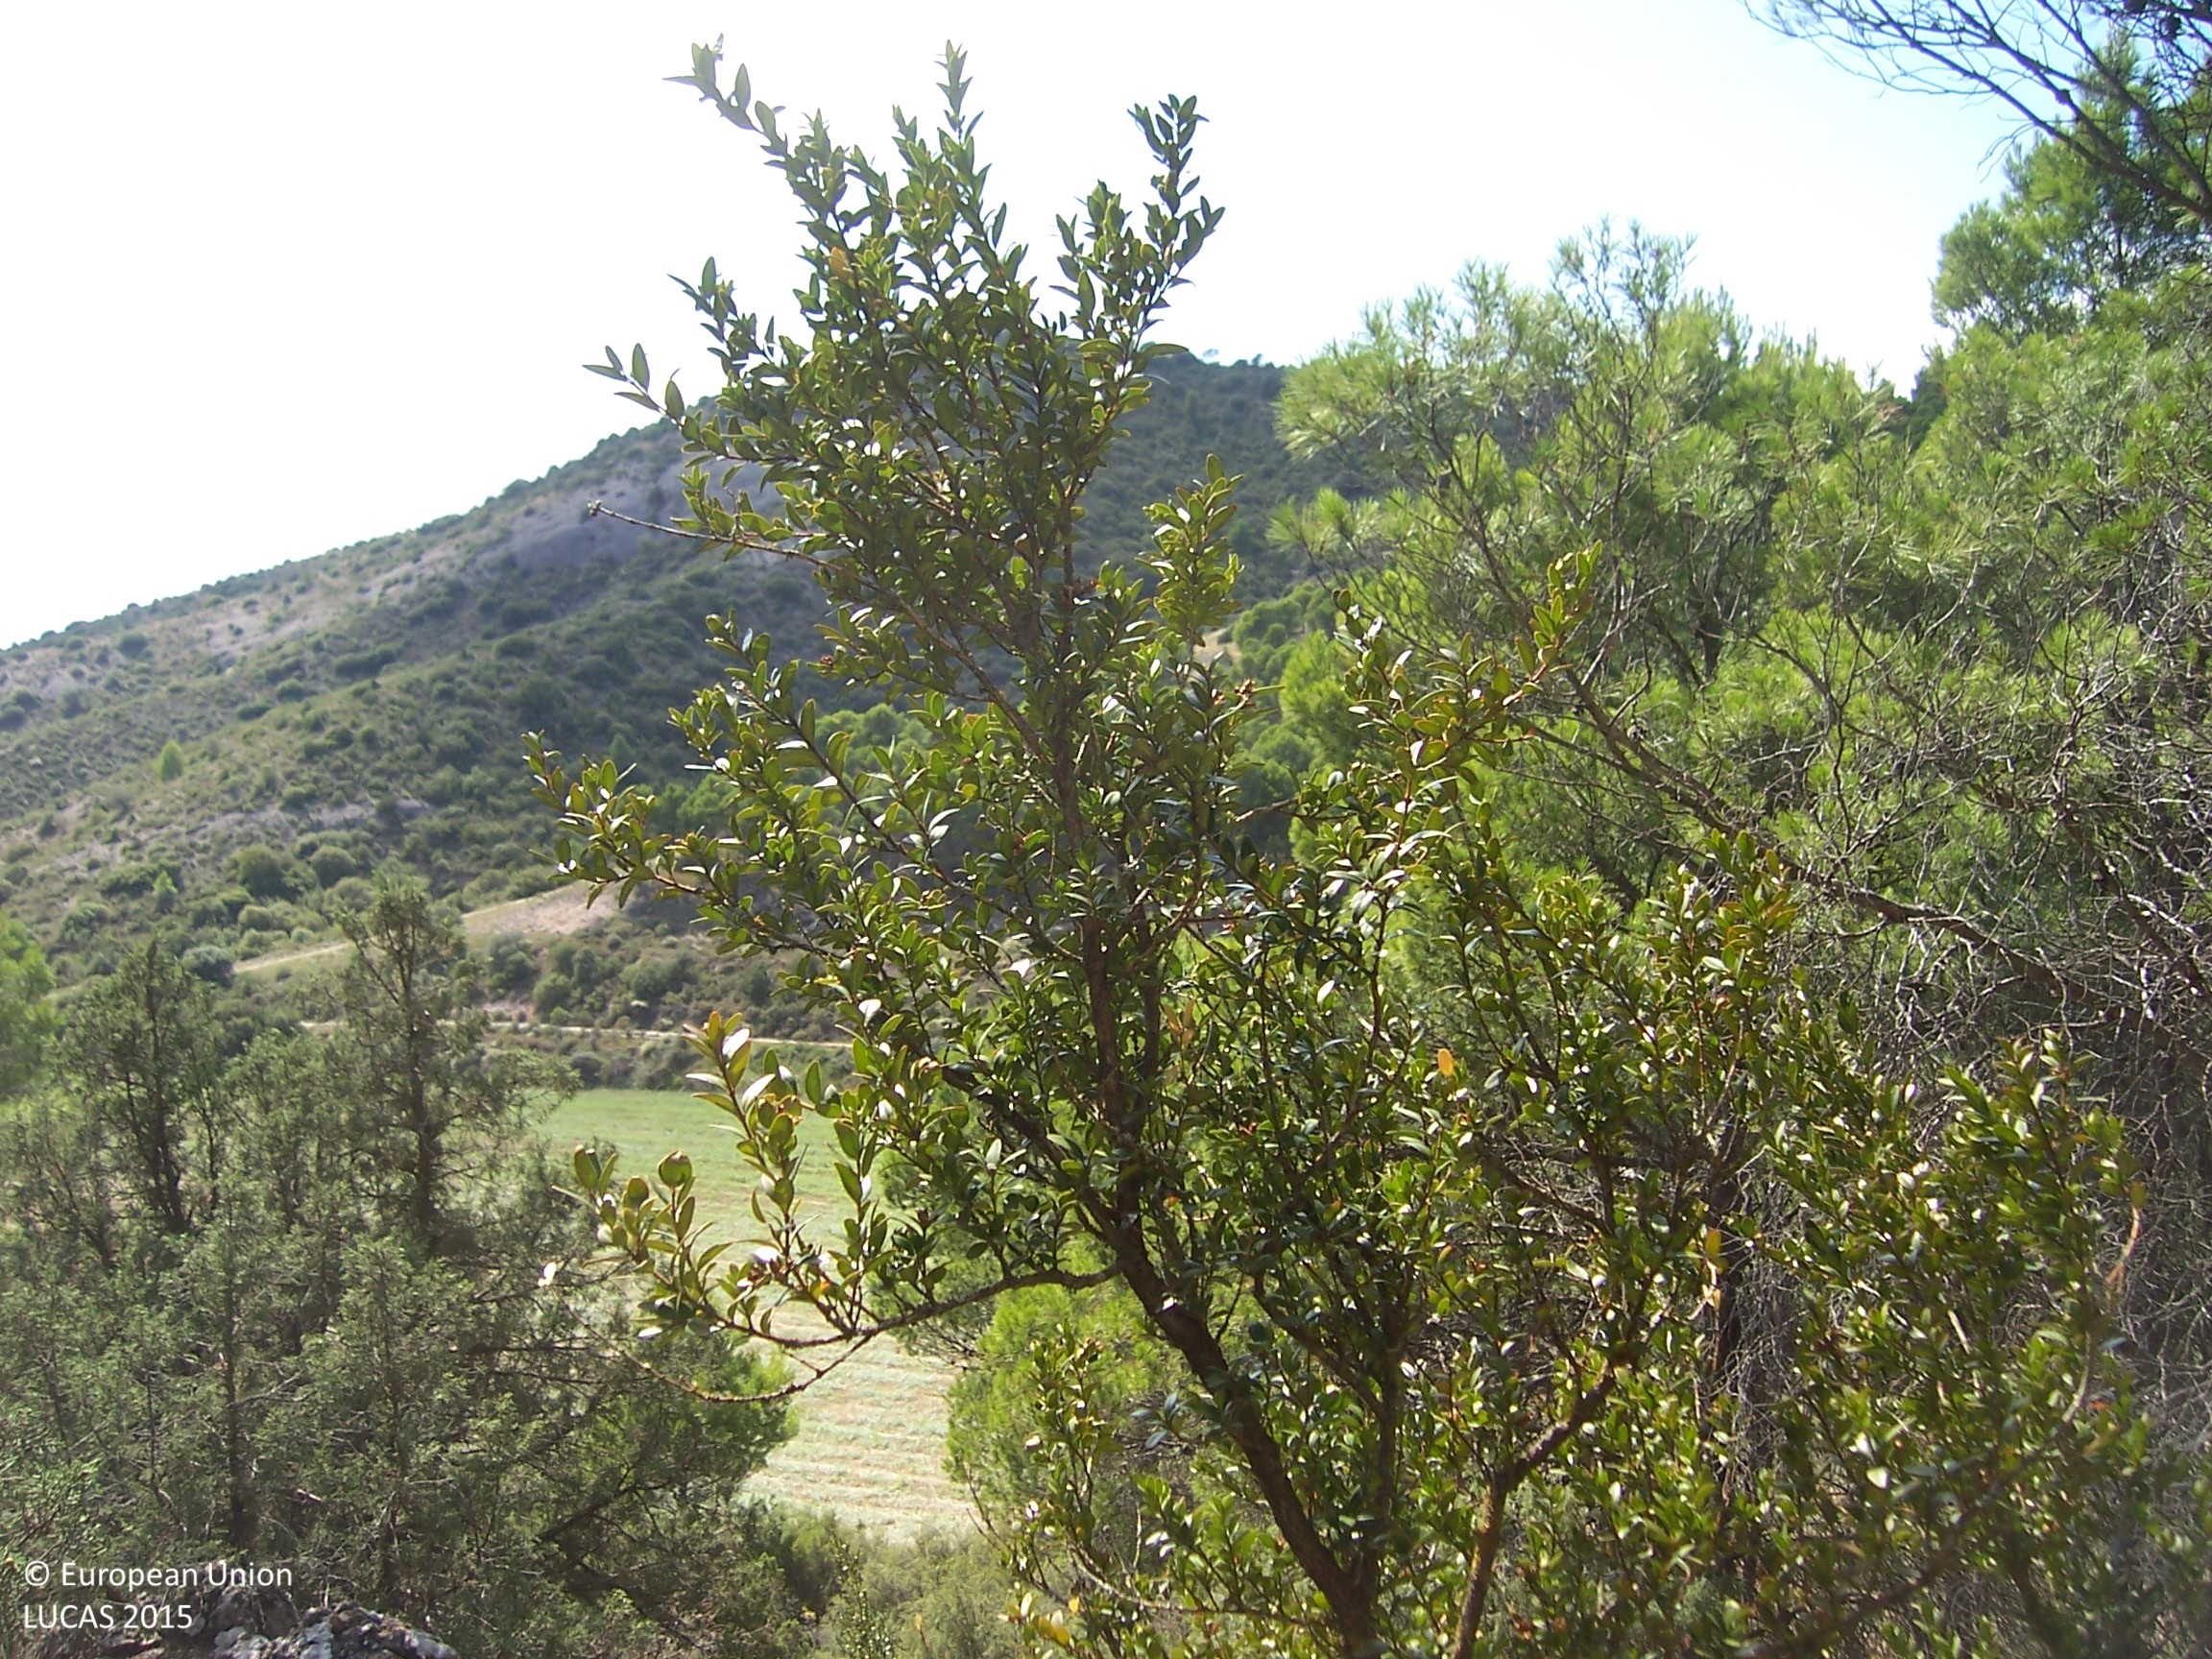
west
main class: Woodland
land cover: Pine dominated coniferous woodland
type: coniferous forest of the mediterranean region
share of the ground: > 75 %
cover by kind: coniferous forest trees 80 %, shrubs 20 %
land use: Forestry
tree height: > 5 m
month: August
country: ES
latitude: 42.0068
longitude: 0.3117
